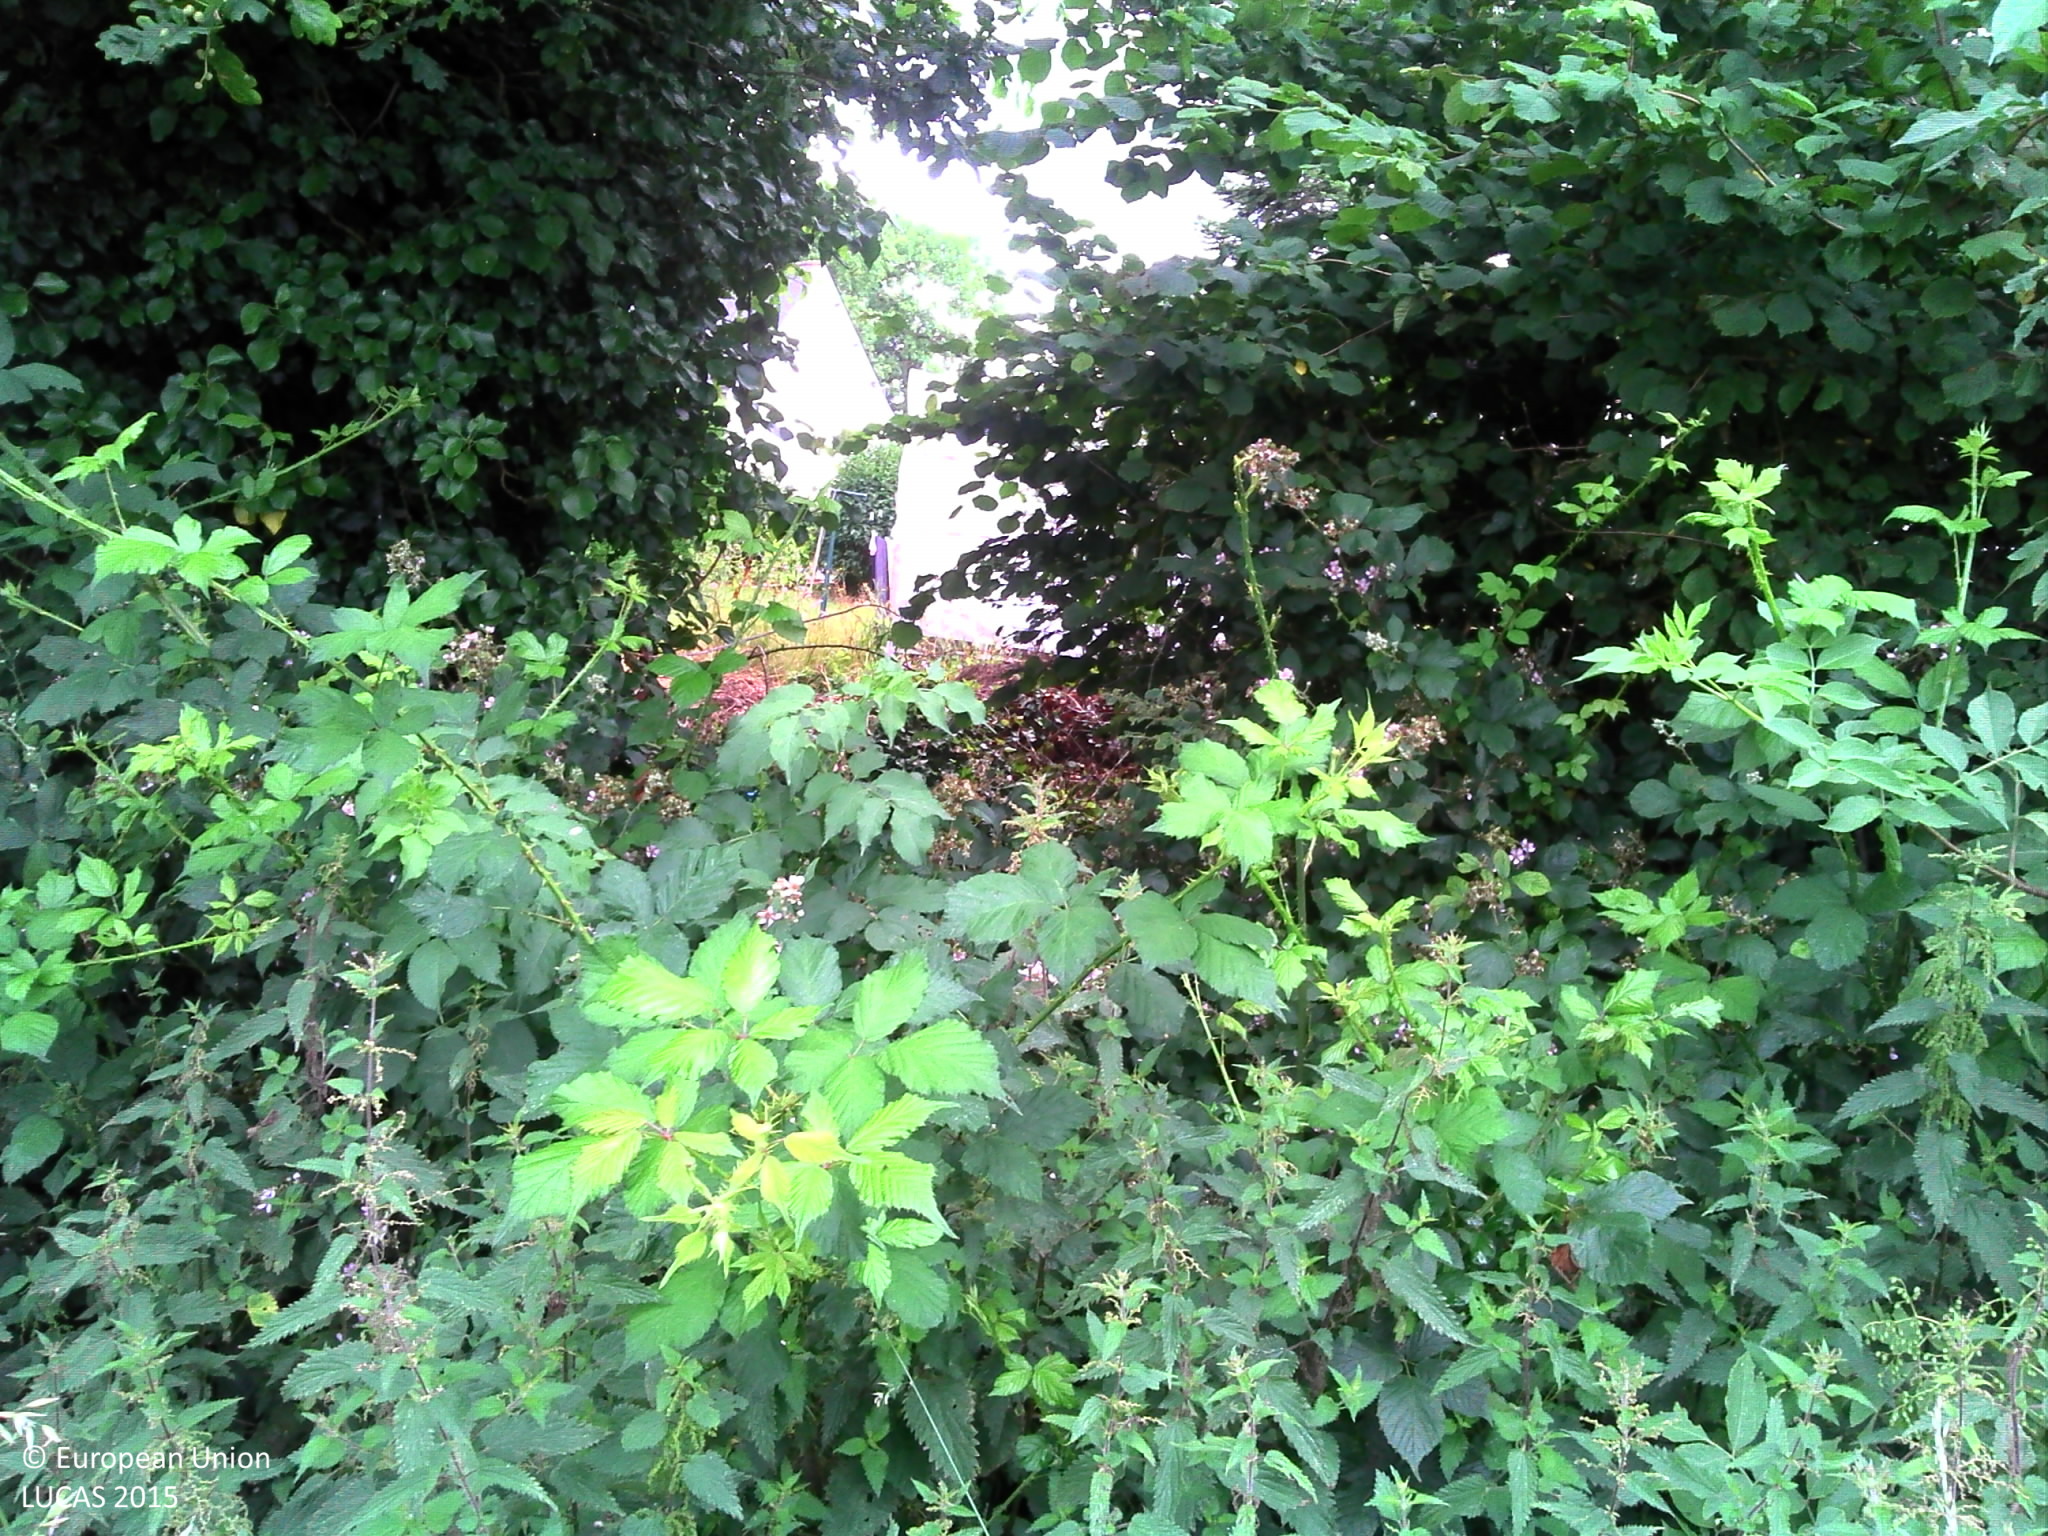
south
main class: Cropland
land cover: Common wheat
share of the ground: > 75 %
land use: Agriculture (excluding fallow land and kitchen gardens)
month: July
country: FR
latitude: 48.2418
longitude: -2.1336
